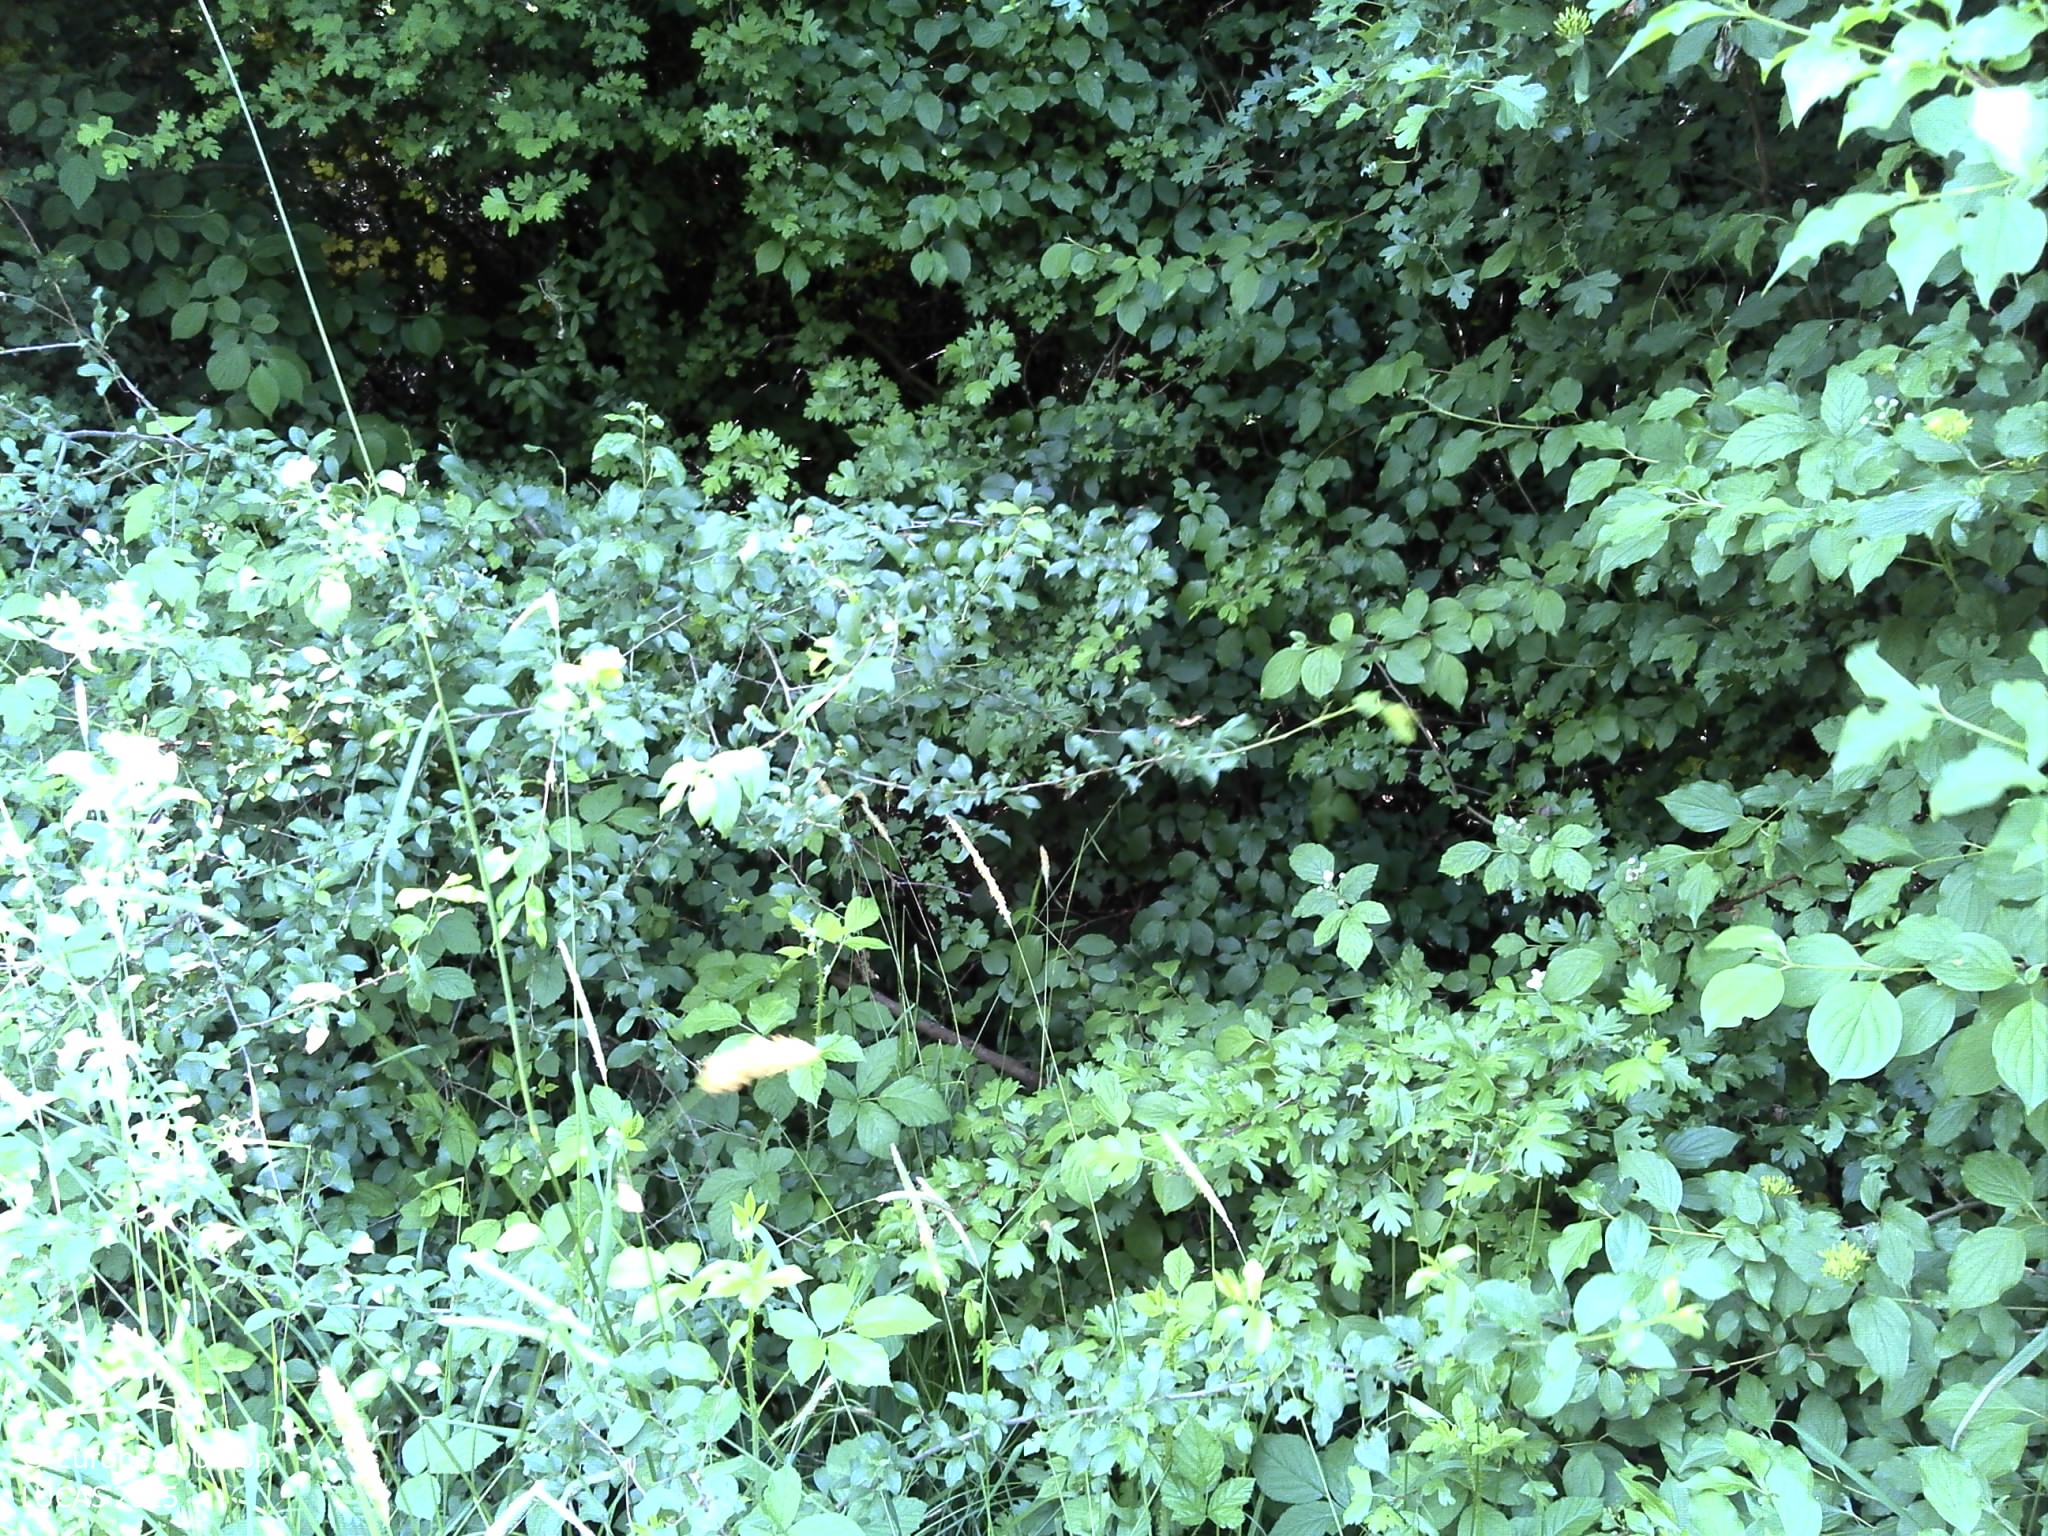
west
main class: Shrubland
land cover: Shrubland with sparse tree cover
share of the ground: > 75 %
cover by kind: shrubs 95 %, broadleaved forest trees 5 %
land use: Forestry
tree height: > 5 m
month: May
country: HR
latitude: 45.6236
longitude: 18.1493
